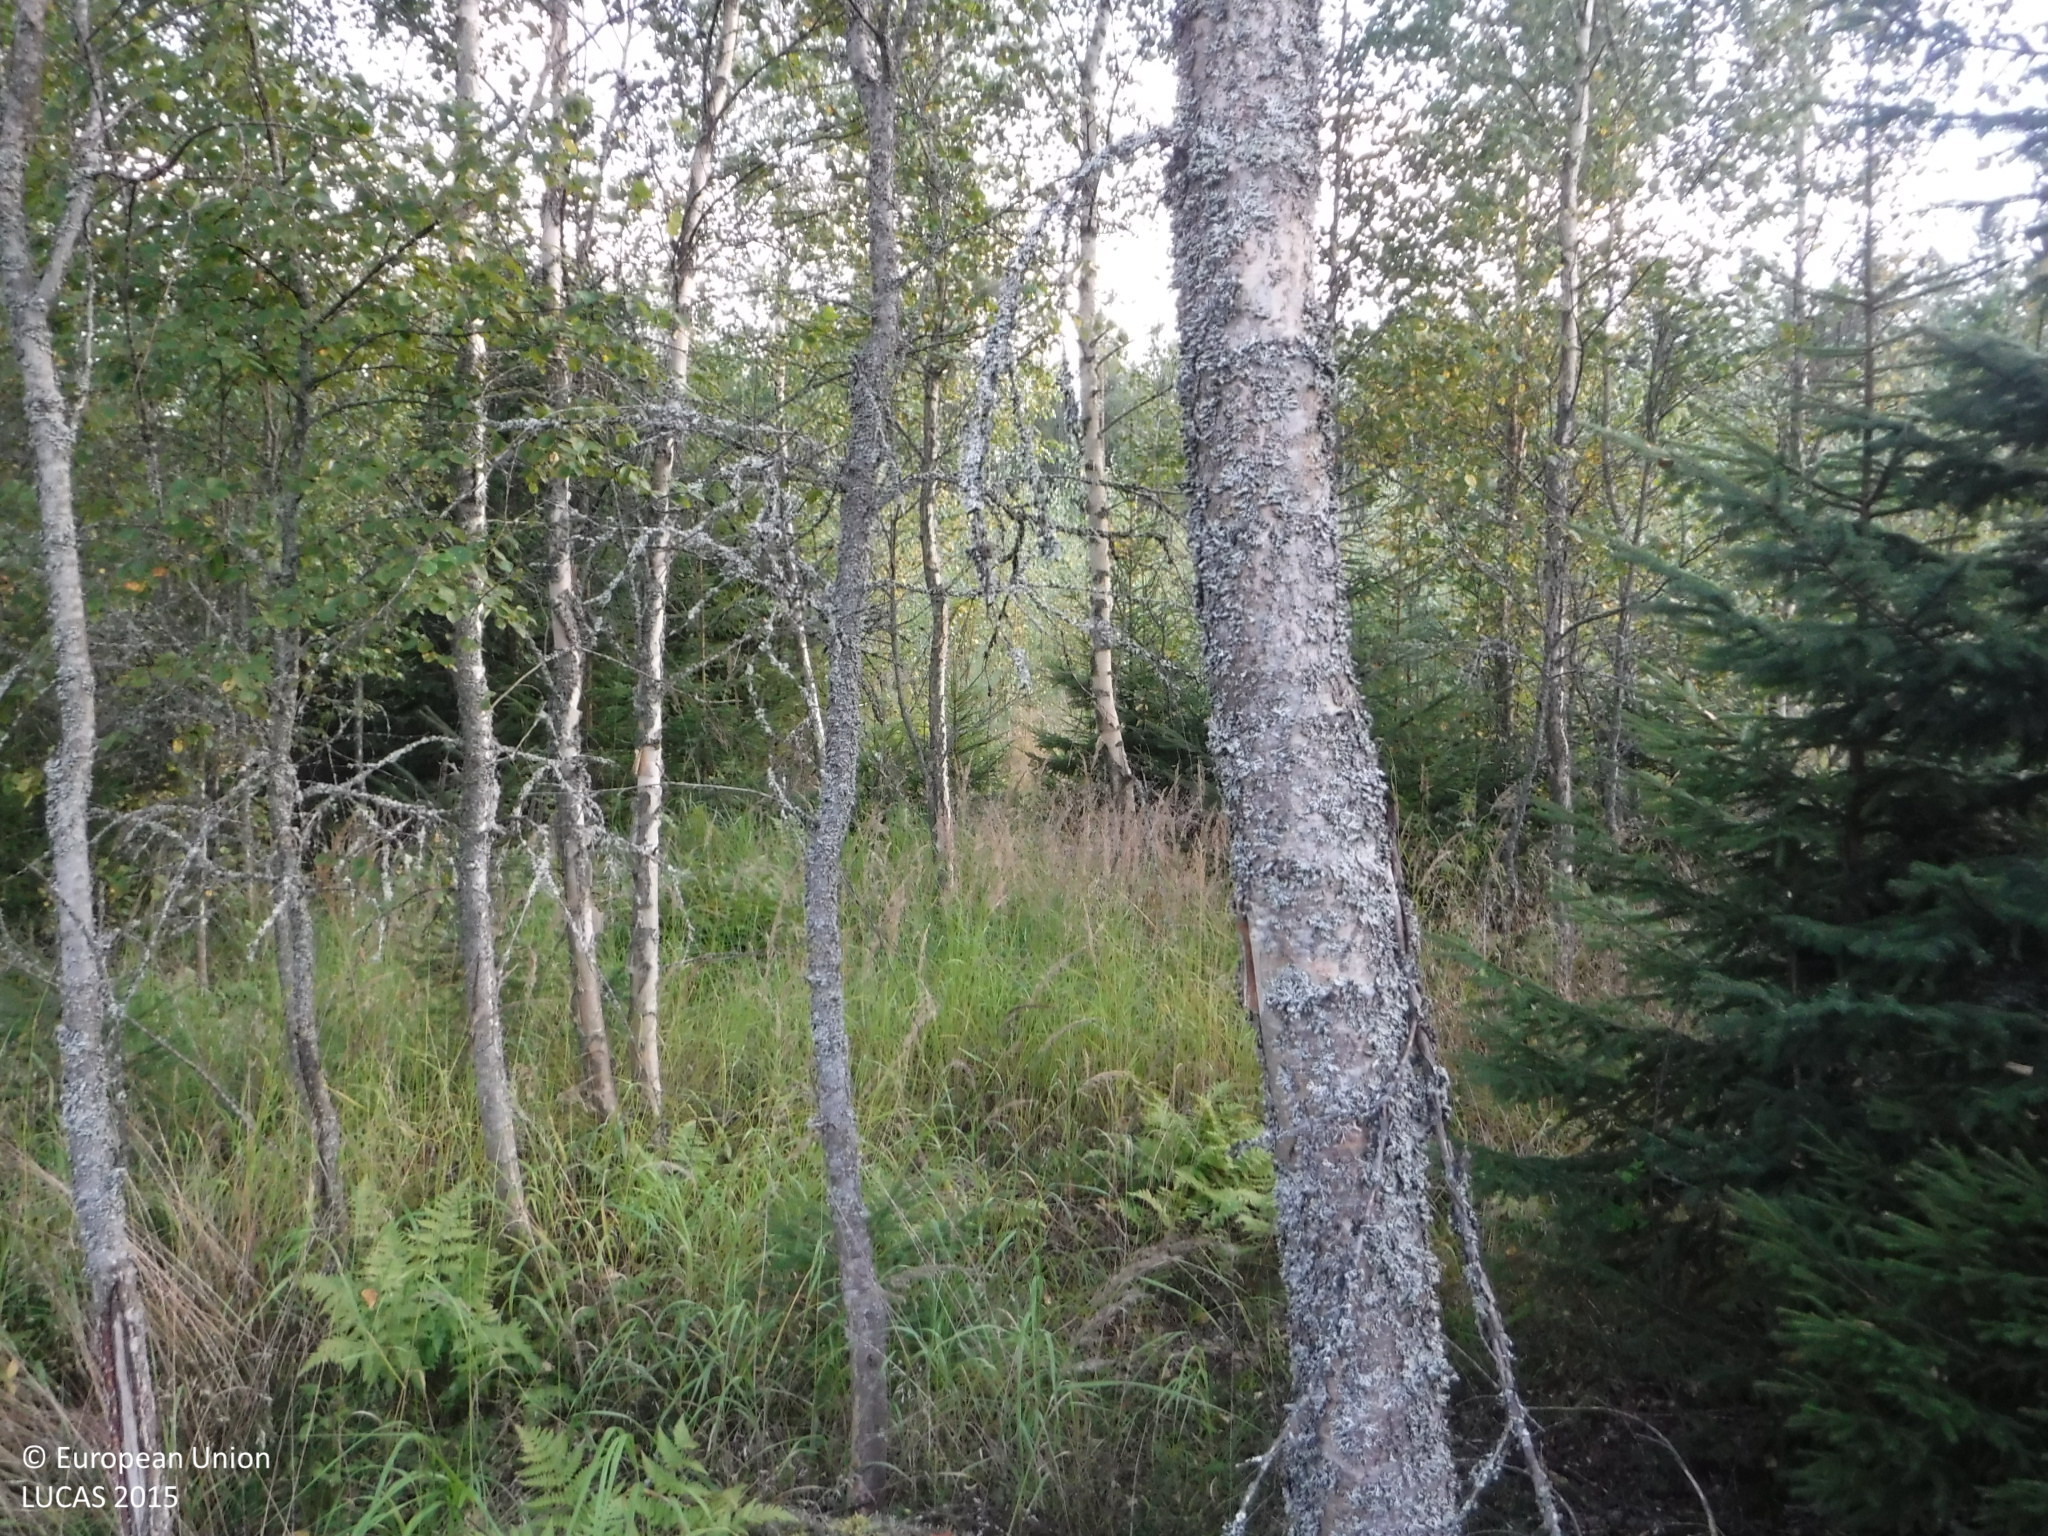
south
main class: Woodland
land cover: Spruce dominated mixed woodland
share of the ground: 50 - 75 %
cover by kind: coniferous forest trees 40 %, broadleaved forest trees 30 %, shrubs 10 %, lichens and mosses 10 %
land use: Forestry
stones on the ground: < 10 %
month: August
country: FI
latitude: 61.1820
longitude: 23.0362
